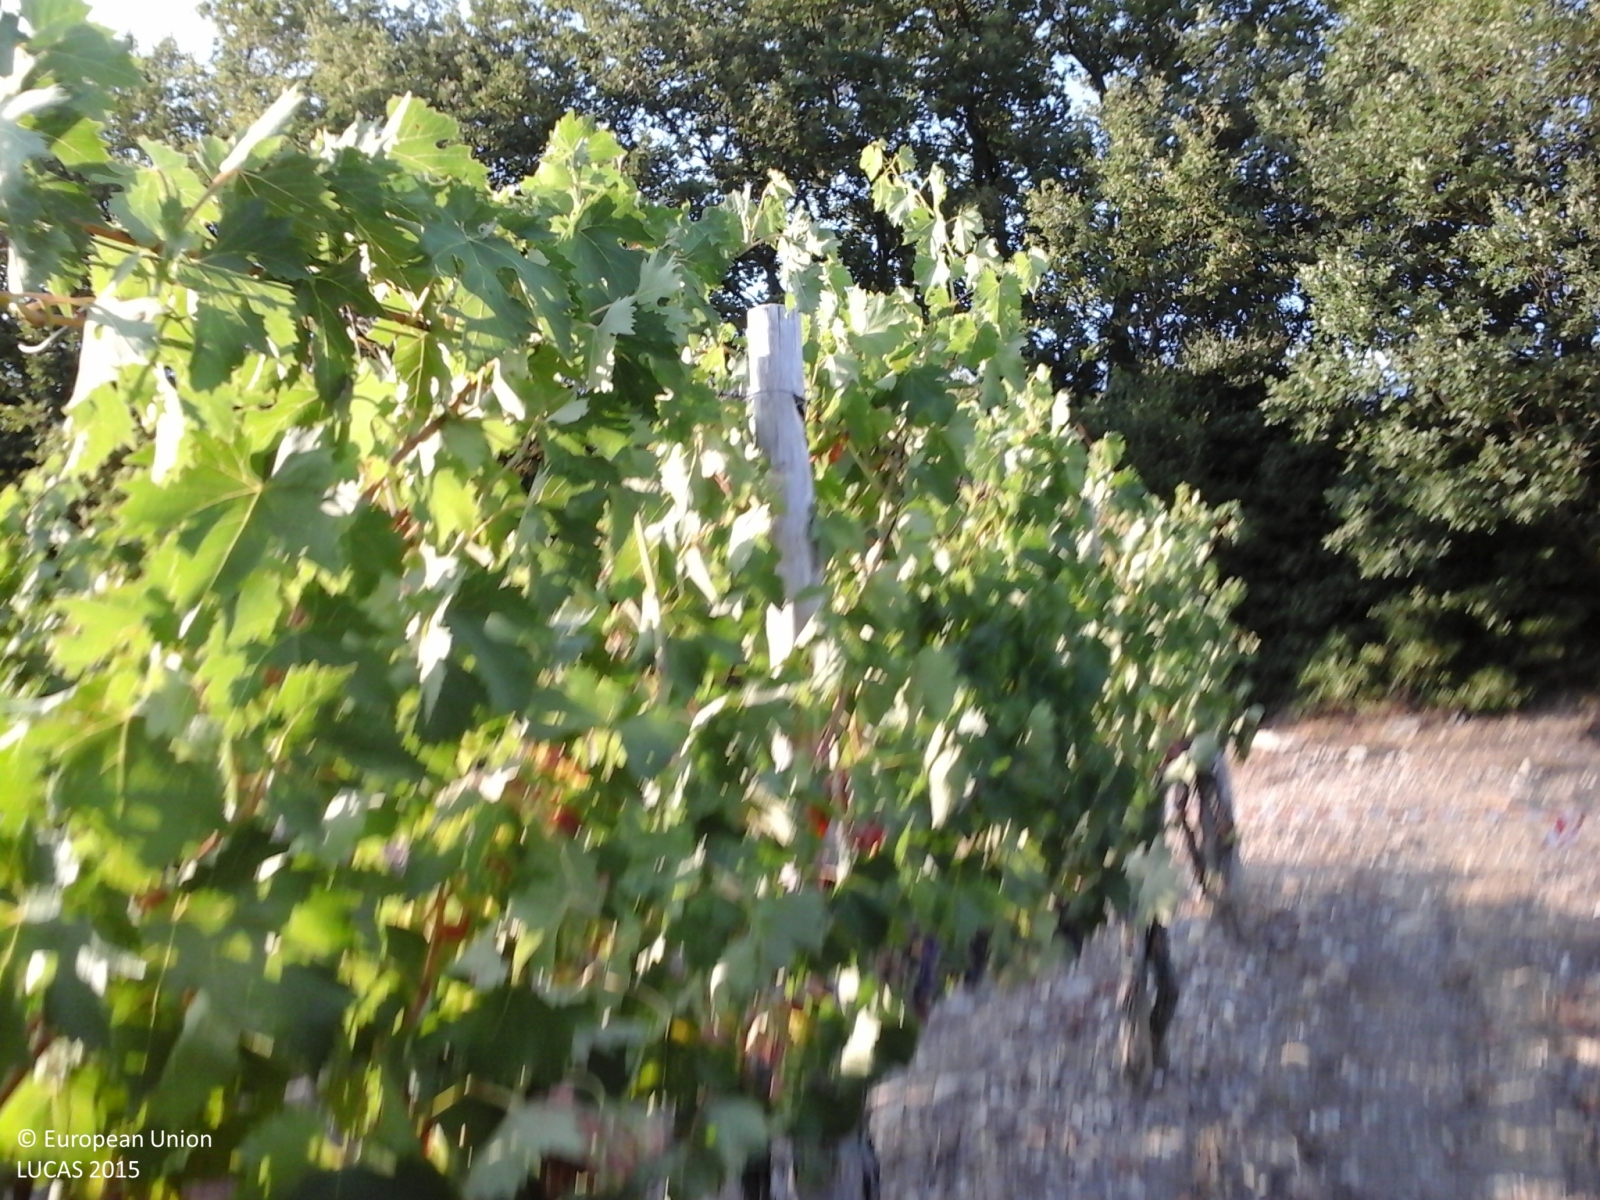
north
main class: Cropland
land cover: Vineyards
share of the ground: 25 - 50 %
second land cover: Other bare soil
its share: > 75 %
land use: Agriculture (excluding fallow land and kitchen gardens)
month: July
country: IT
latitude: 43.0766
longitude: 11.4816
